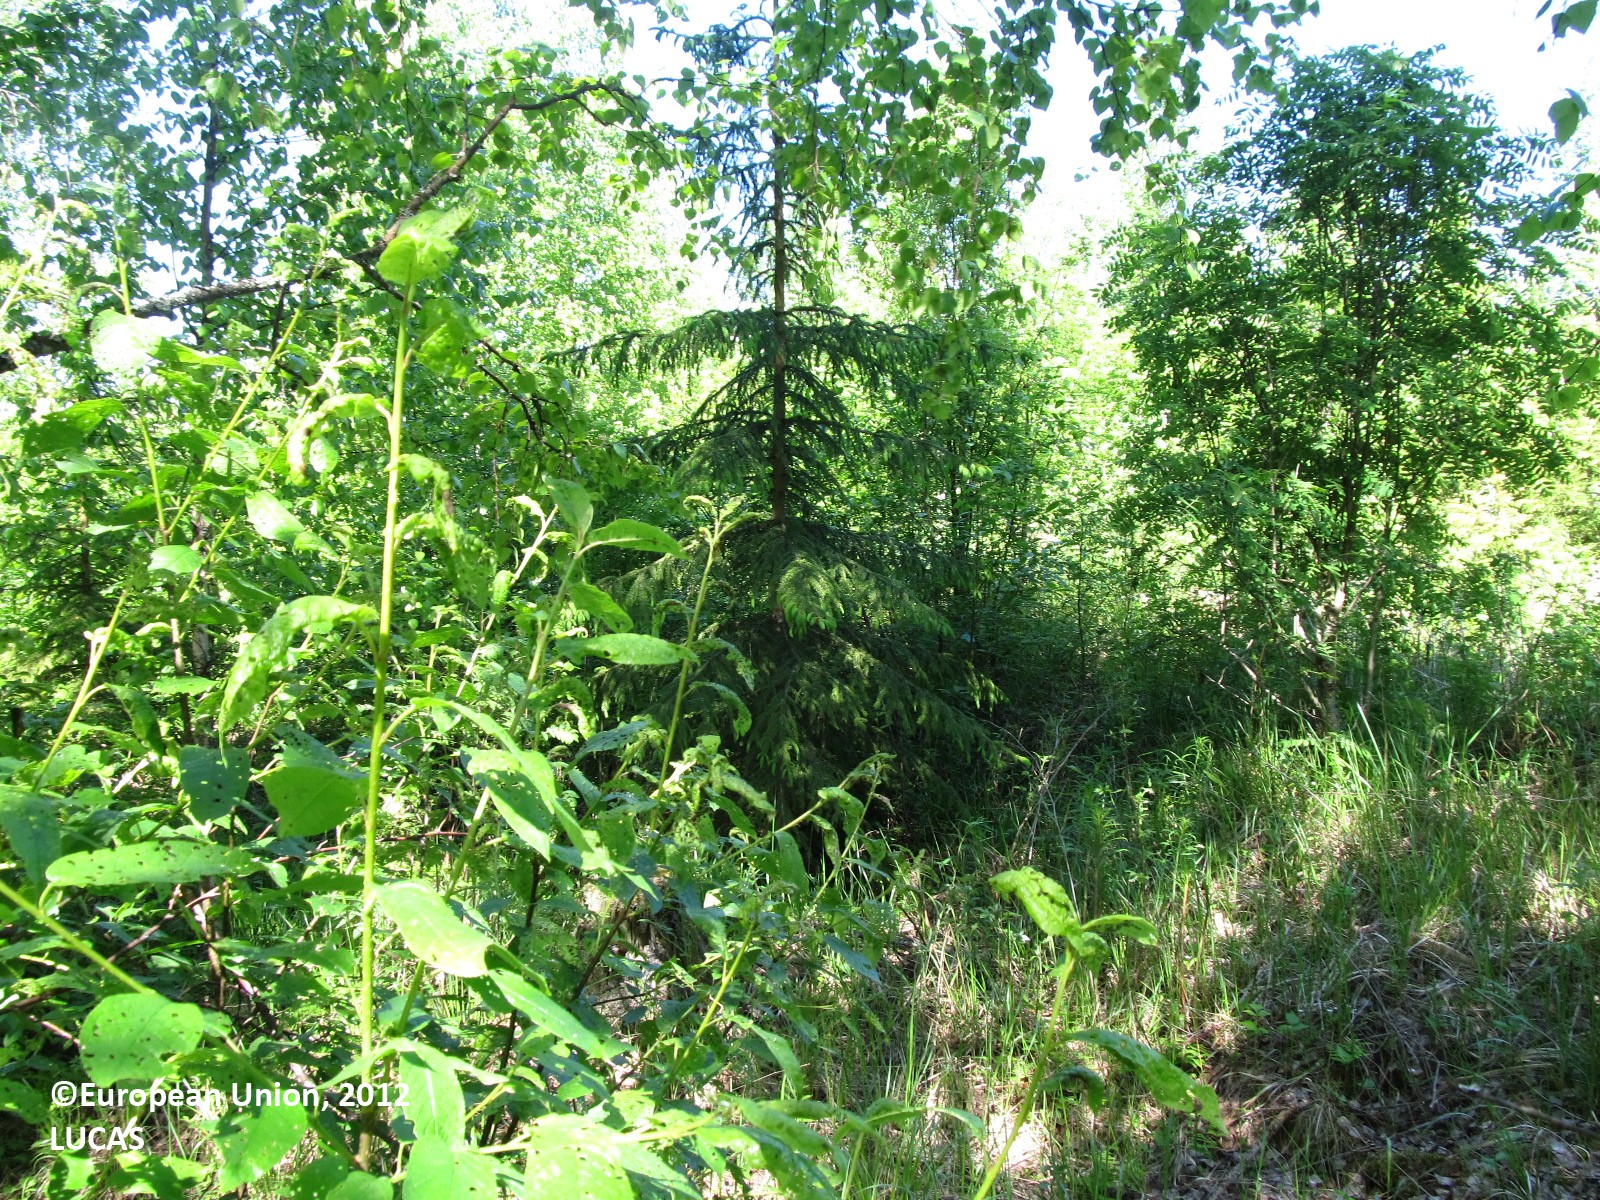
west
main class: Woodland
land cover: Broadleaved woodland
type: boreal forest
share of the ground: 50 - 75 %
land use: Forestry
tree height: > 5 m
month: June
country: FI
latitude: 62.6761
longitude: 27.4457
